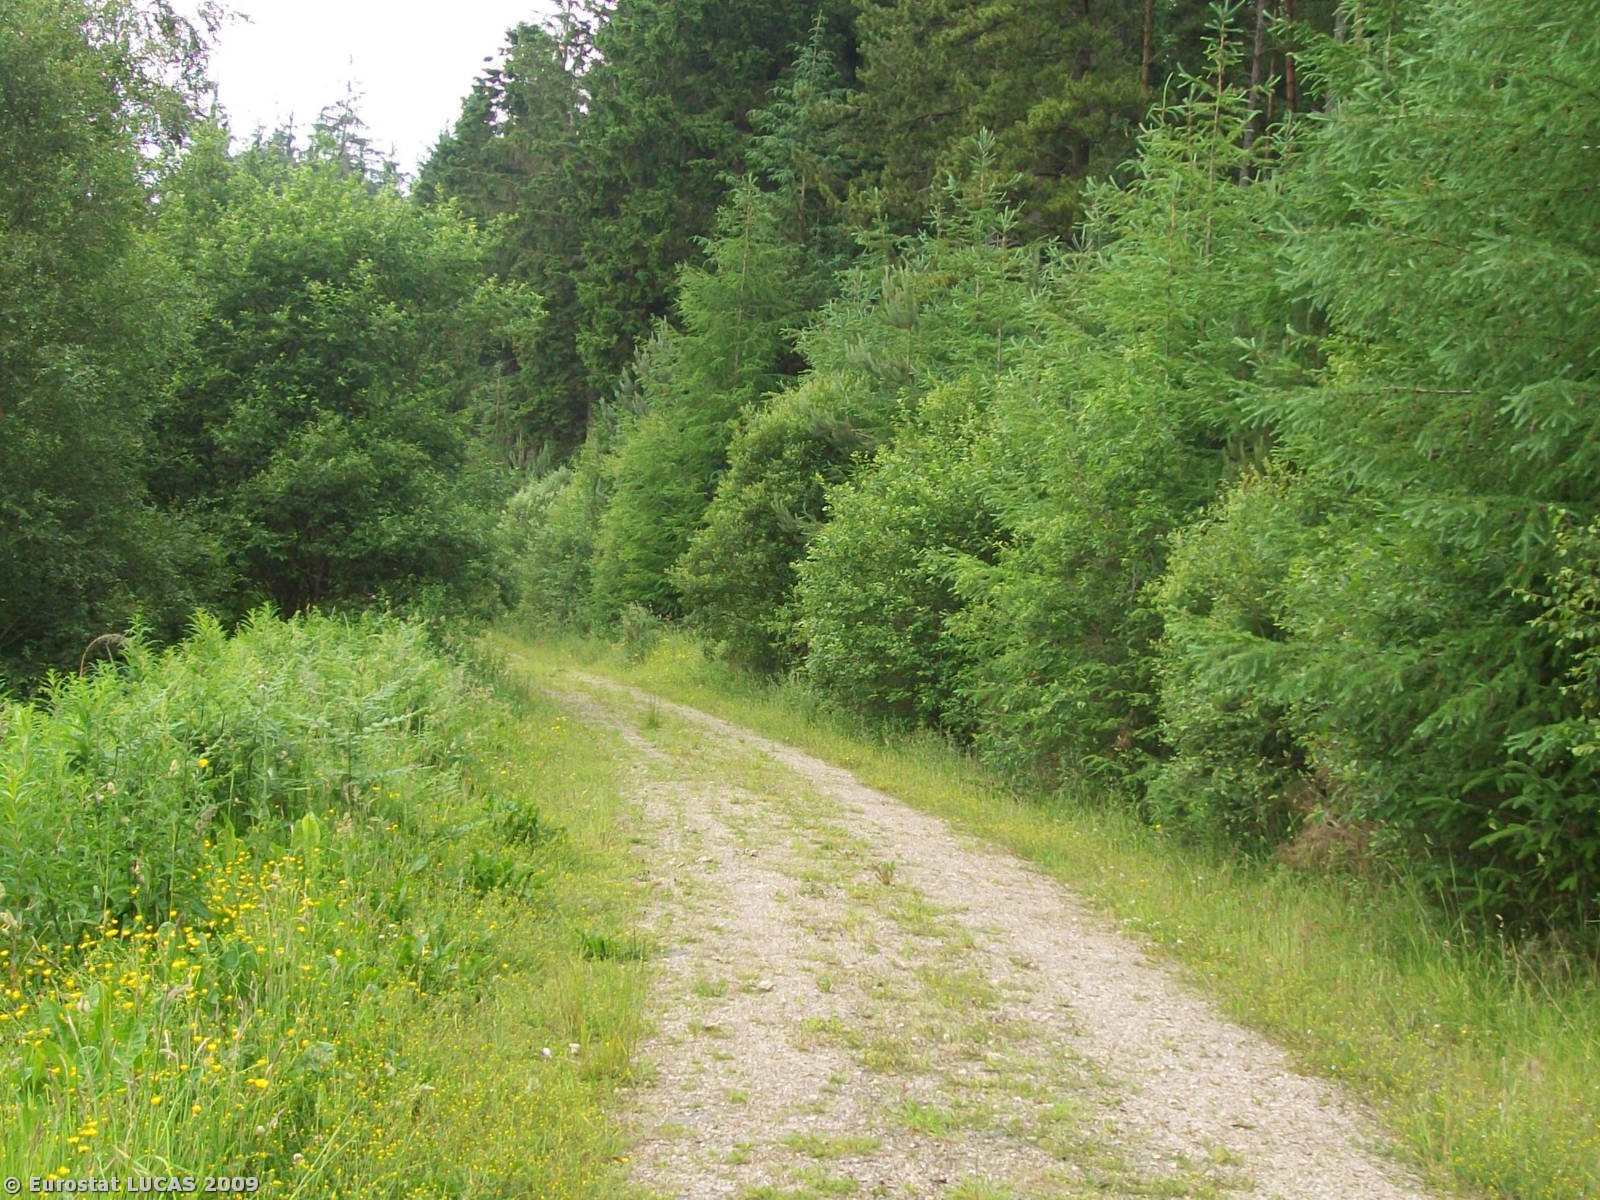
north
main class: Grassland
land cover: Grassland with sparse tree/shrub cover
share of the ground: 50 - 75 %
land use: Forestry
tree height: > 5 m
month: June
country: GB
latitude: 53.0501
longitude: -3.4343
